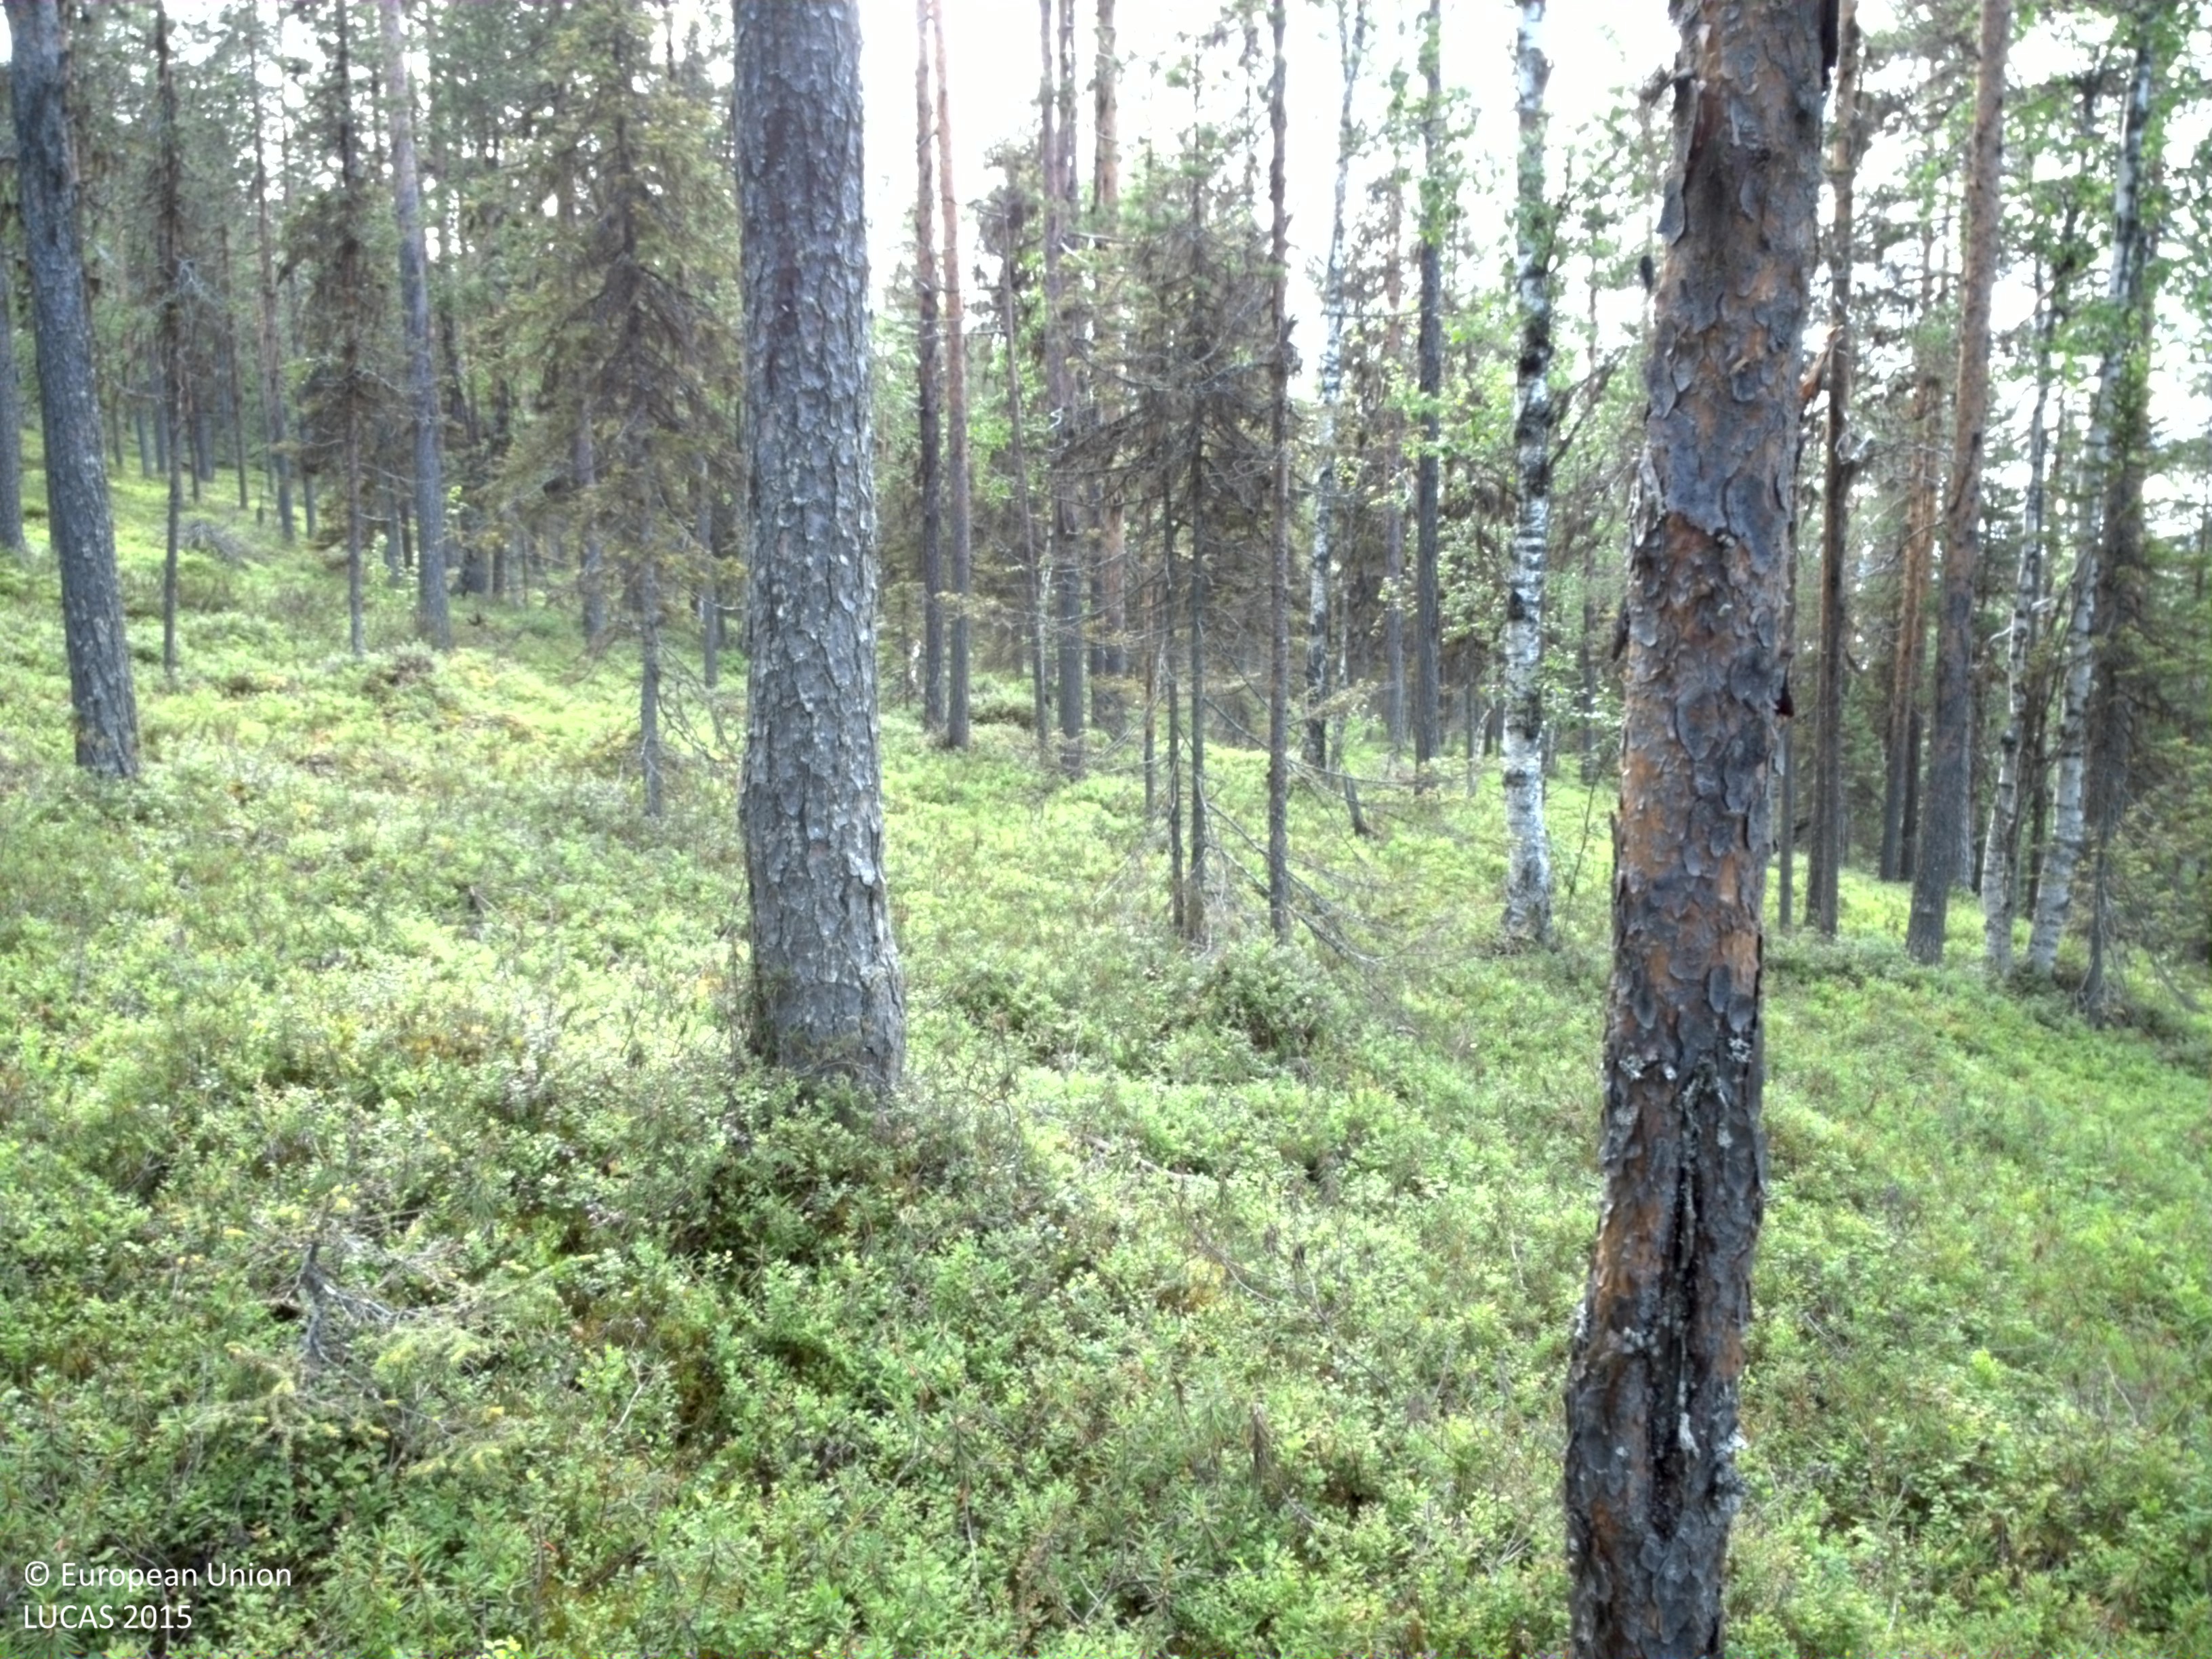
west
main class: Woodland
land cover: Pine dominated coniferous woodland
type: boreal forest
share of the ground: 25 - 50 %
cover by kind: shrubs 65 %, coniferous forest trees 30 %, broadleaved forest trees 5 %
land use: Forestry
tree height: > 5 m
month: August
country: SE
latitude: 66.5626
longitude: 20.0246
